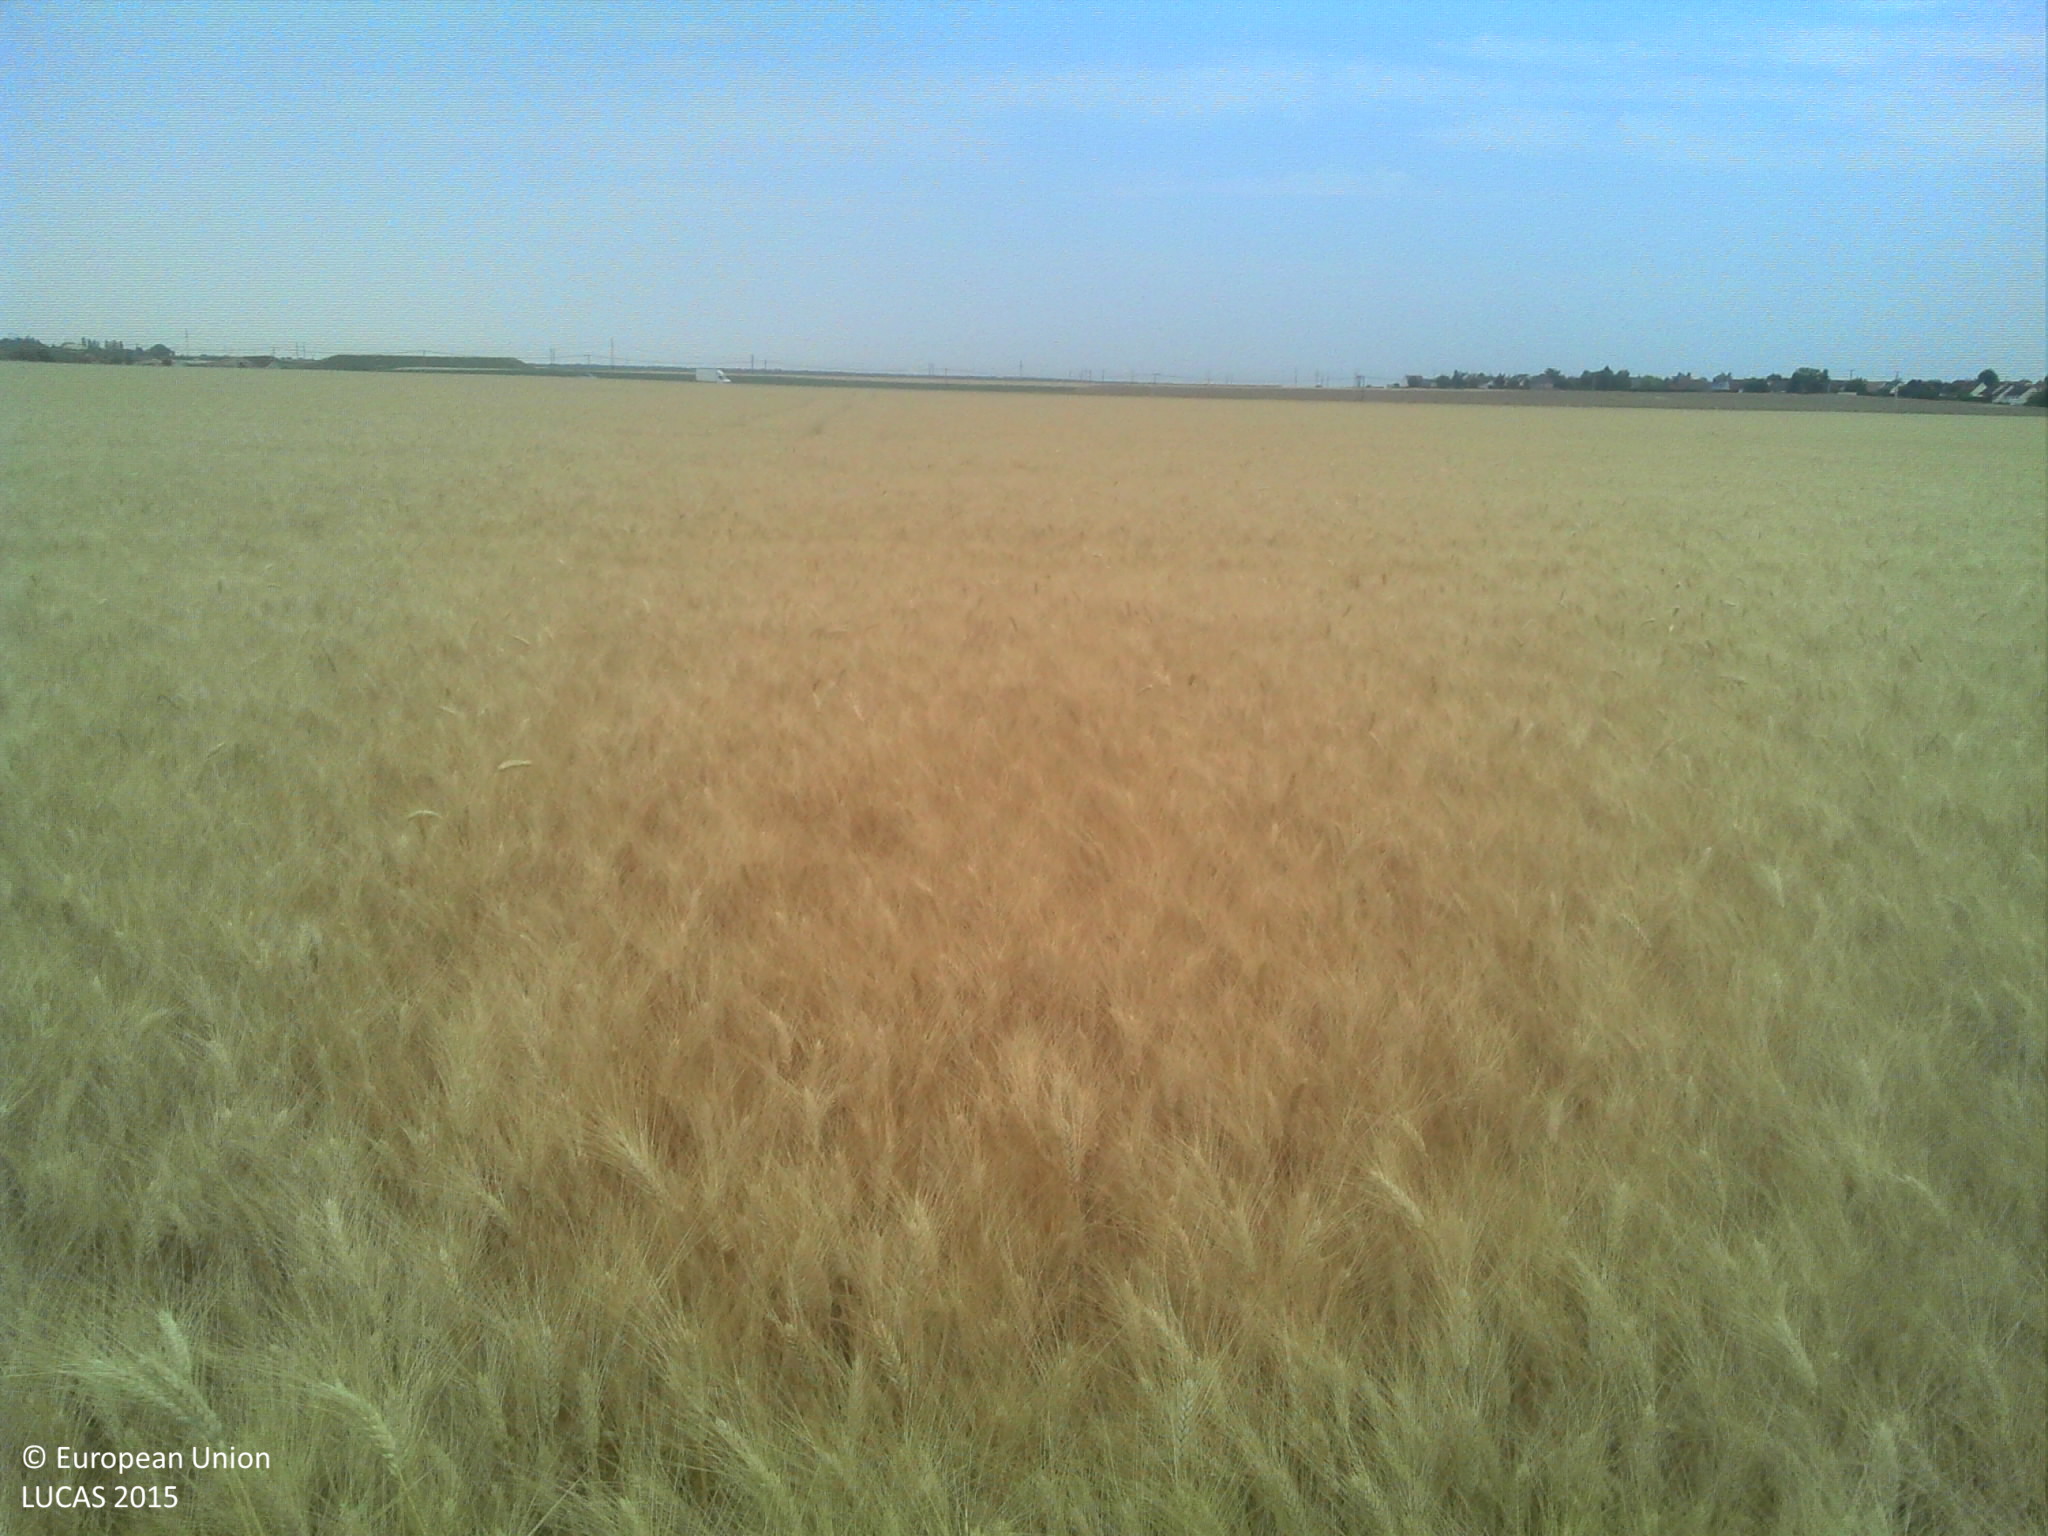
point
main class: Cropland
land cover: Durum wheat
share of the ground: > 75 %
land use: Agriculture (excluding fallow land and kitchen gardens)
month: July
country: FR
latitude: 47.6274
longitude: 1.3214
